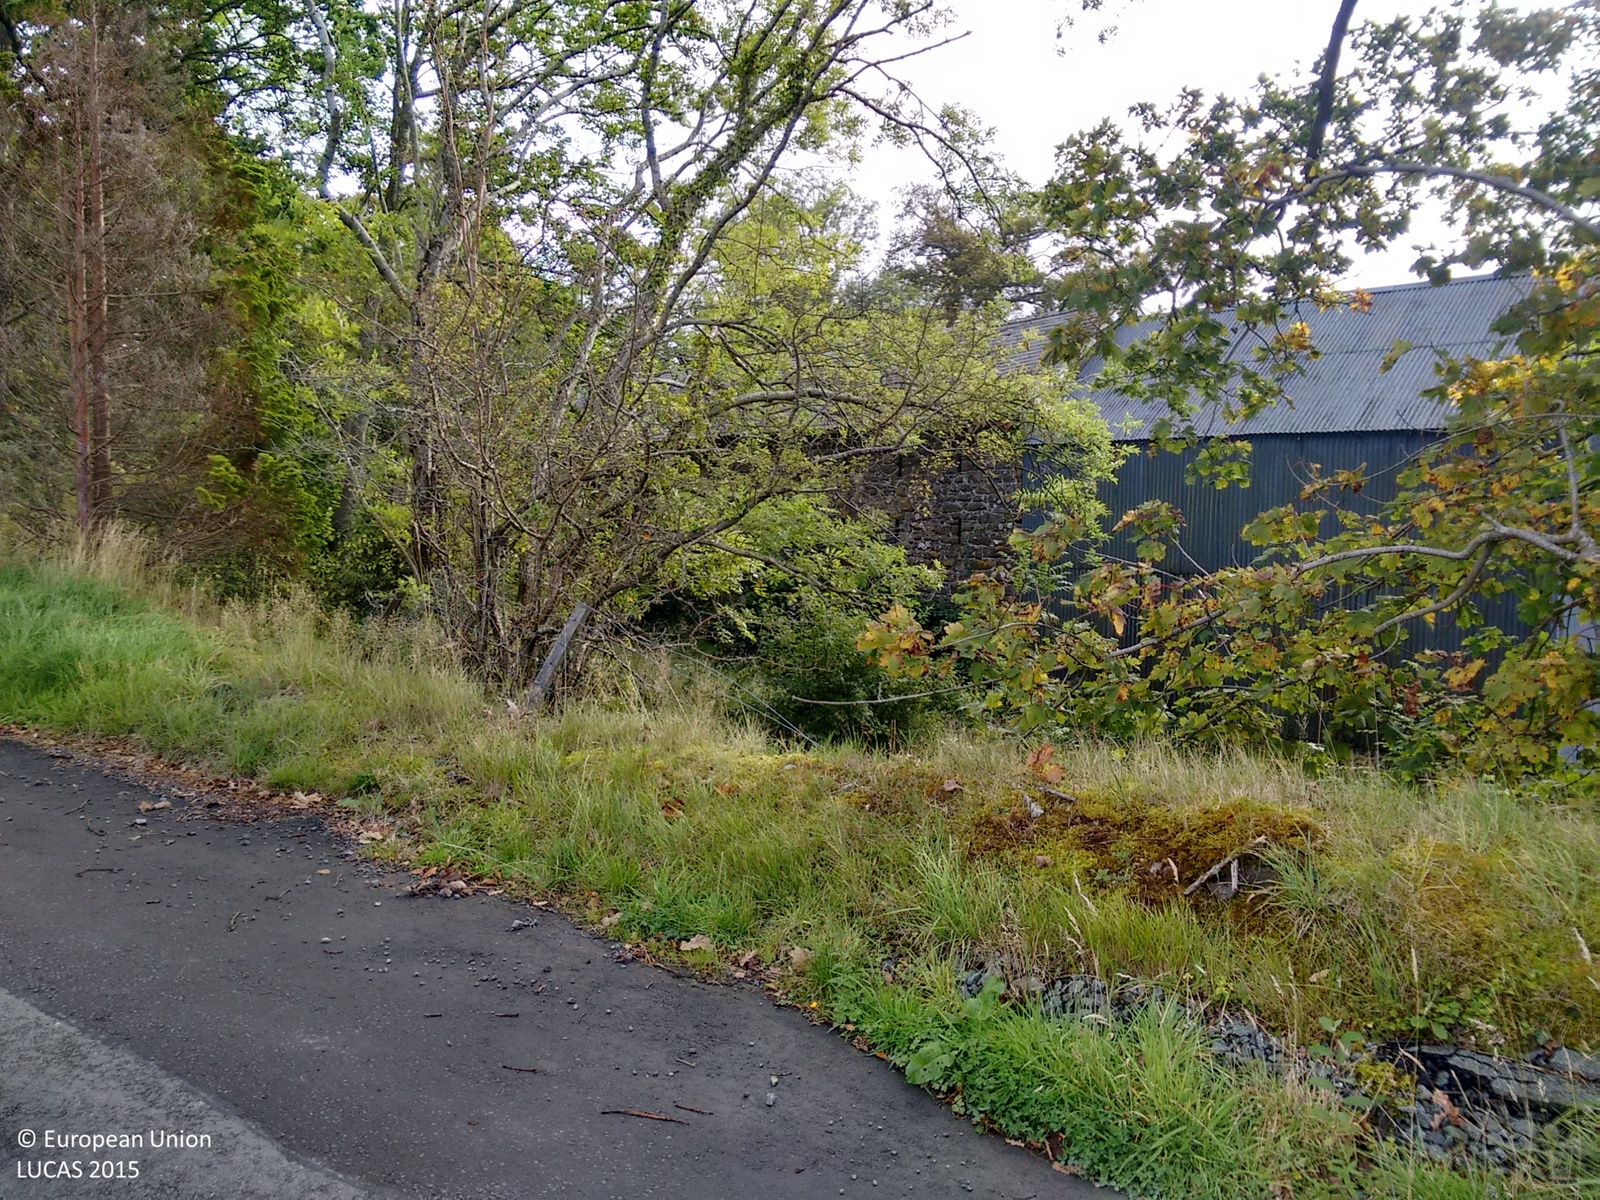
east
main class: Grassland
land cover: Grassland without tree/shrub cover
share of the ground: > 75 %
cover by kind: herbaceous plants 100 %
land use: Agriculture (excluding fallow land and kitchen gardens)
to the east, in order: Grassland without tree/shrub cover; Fences; Tracks; Broadleaved woodland; Artificial constructions in urban areas; Grassland without tree/shrub cover; Tracks; Grassland without tree/shrub cover; Managed hedges; Grassland without tree/shrub cover; Tracks; Grass margins; Managed hedges; Grassland without tree/shrub cover
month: September
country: GB
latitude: 52.5798
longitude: -3.5592
